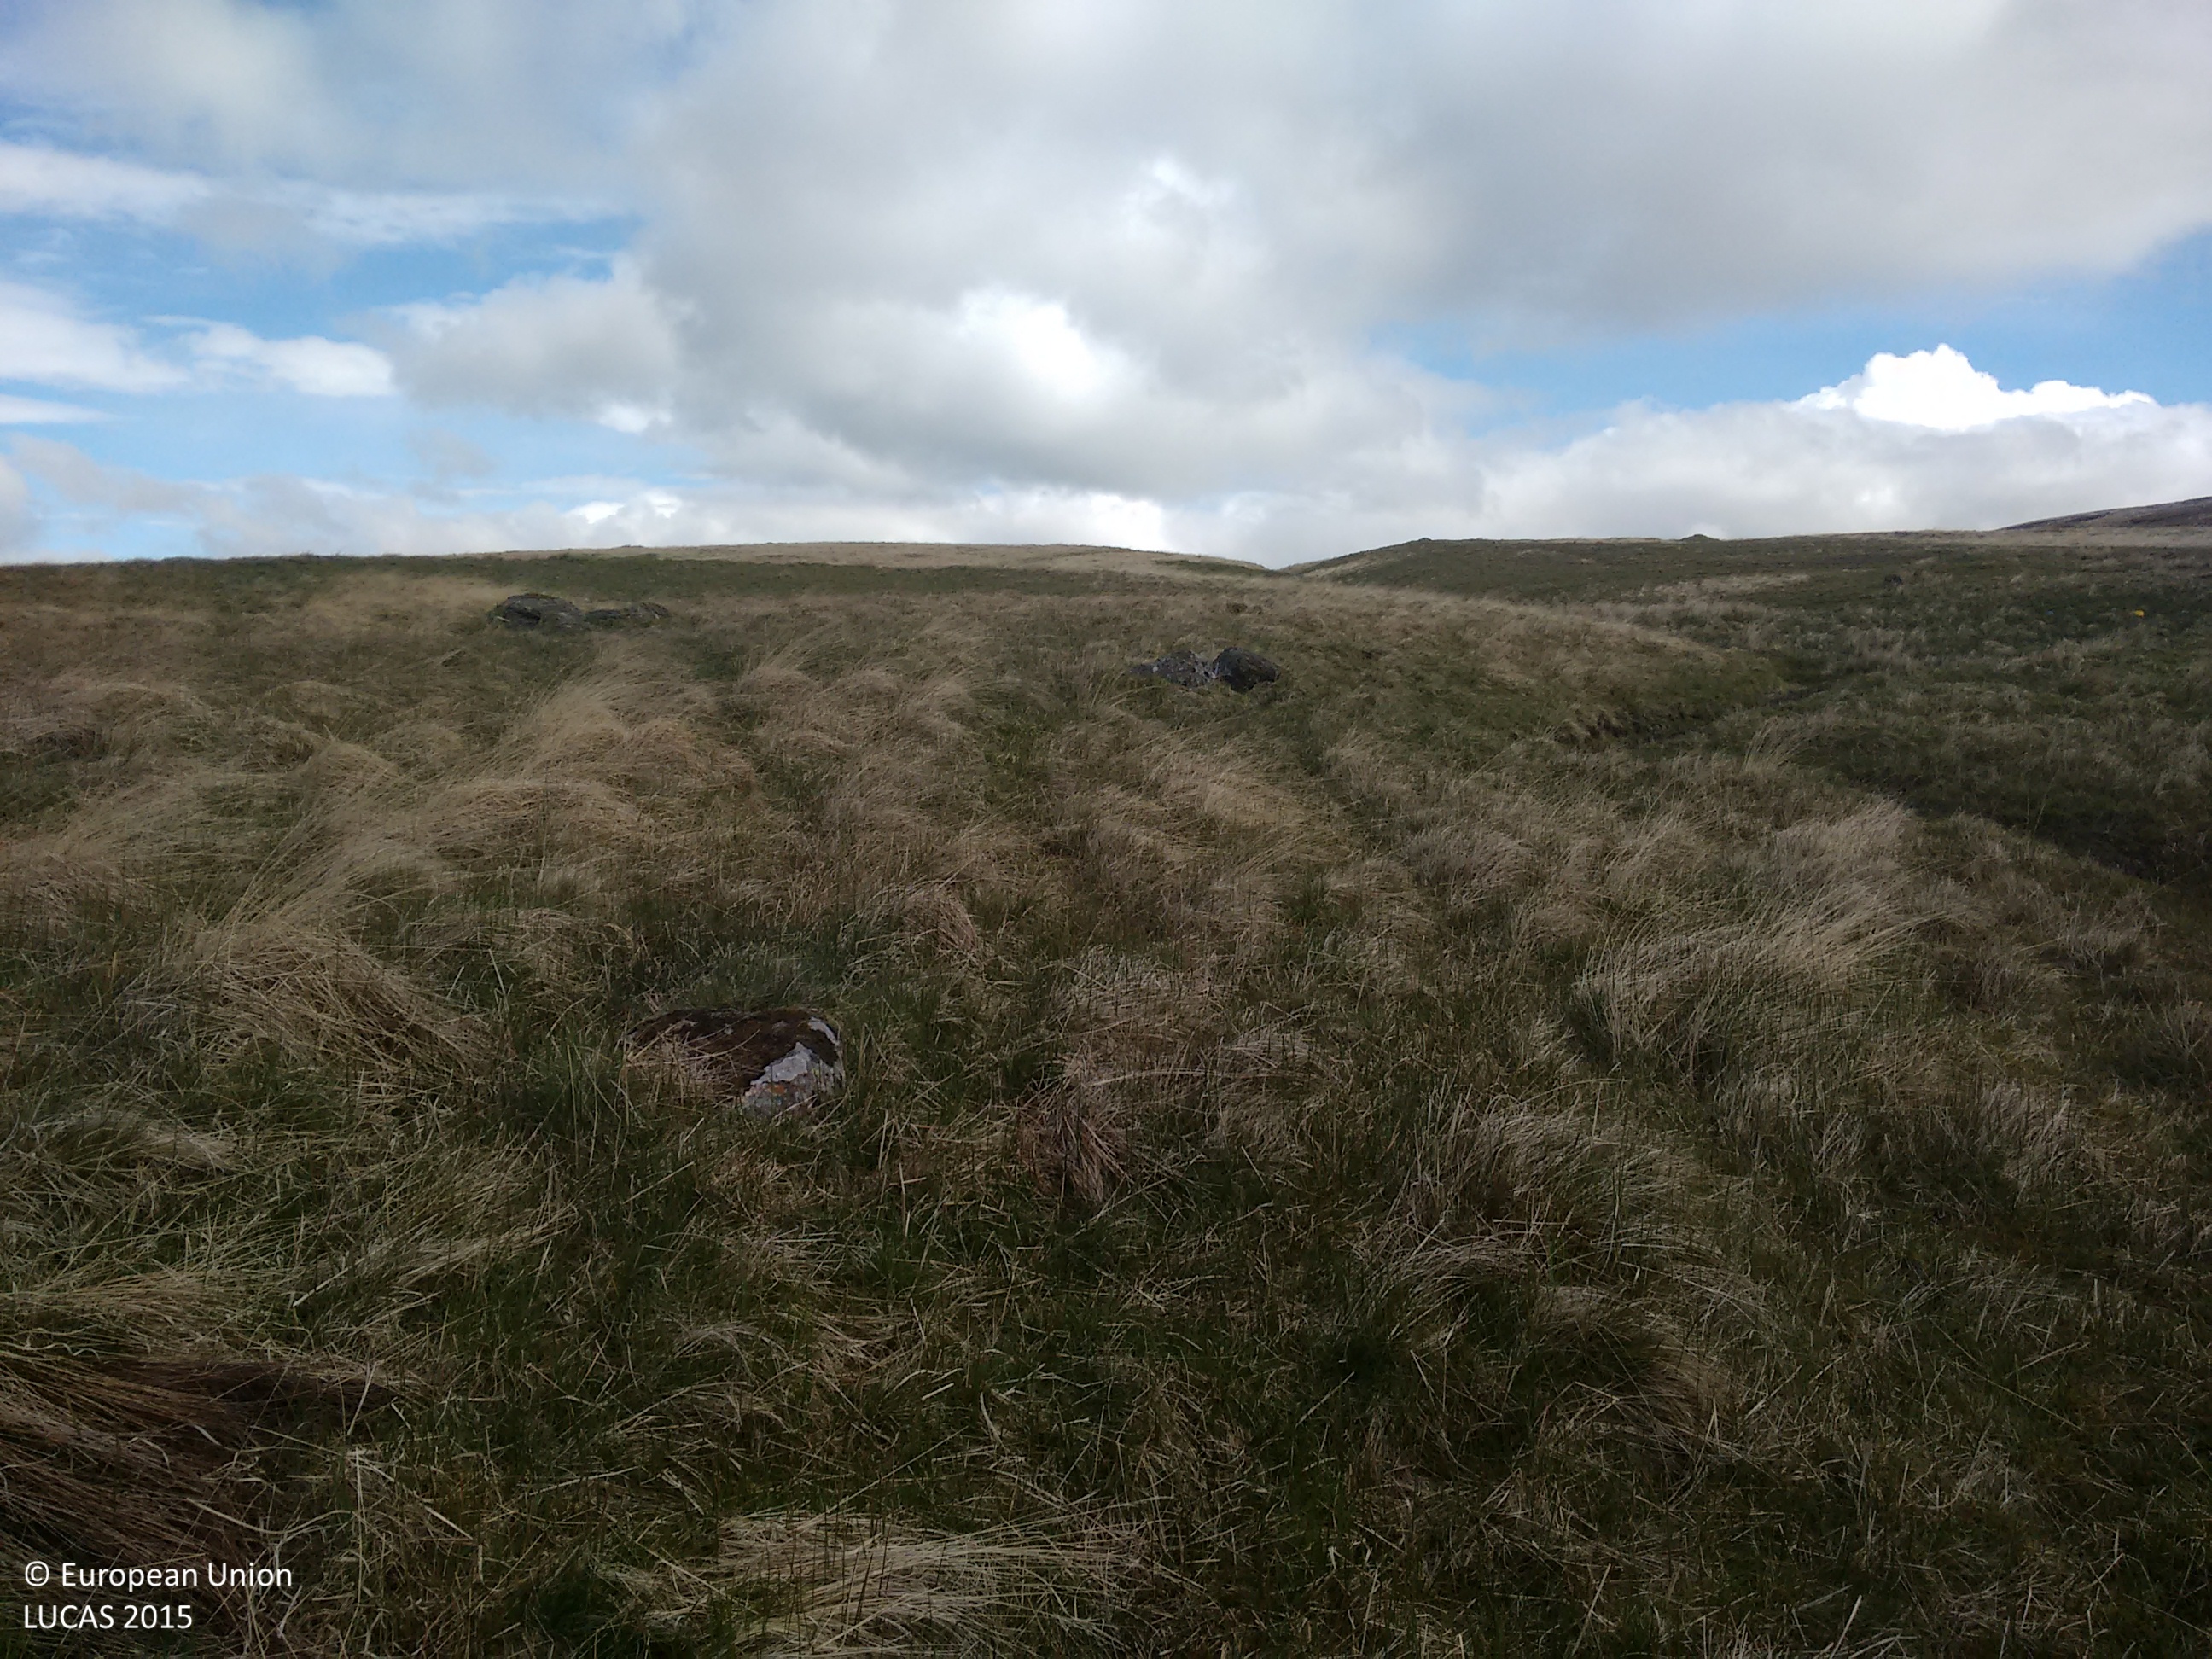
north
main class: Grassland
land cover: Grassland without tree/shrub cover
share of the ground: > 75 %
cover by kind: herbaceous plants 80 %, lichens and mosses 20 %
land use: Agriculture (excluding fallow land and kitchen gardens)
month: May
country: GB
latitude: 56.3139
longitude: -3.9721
